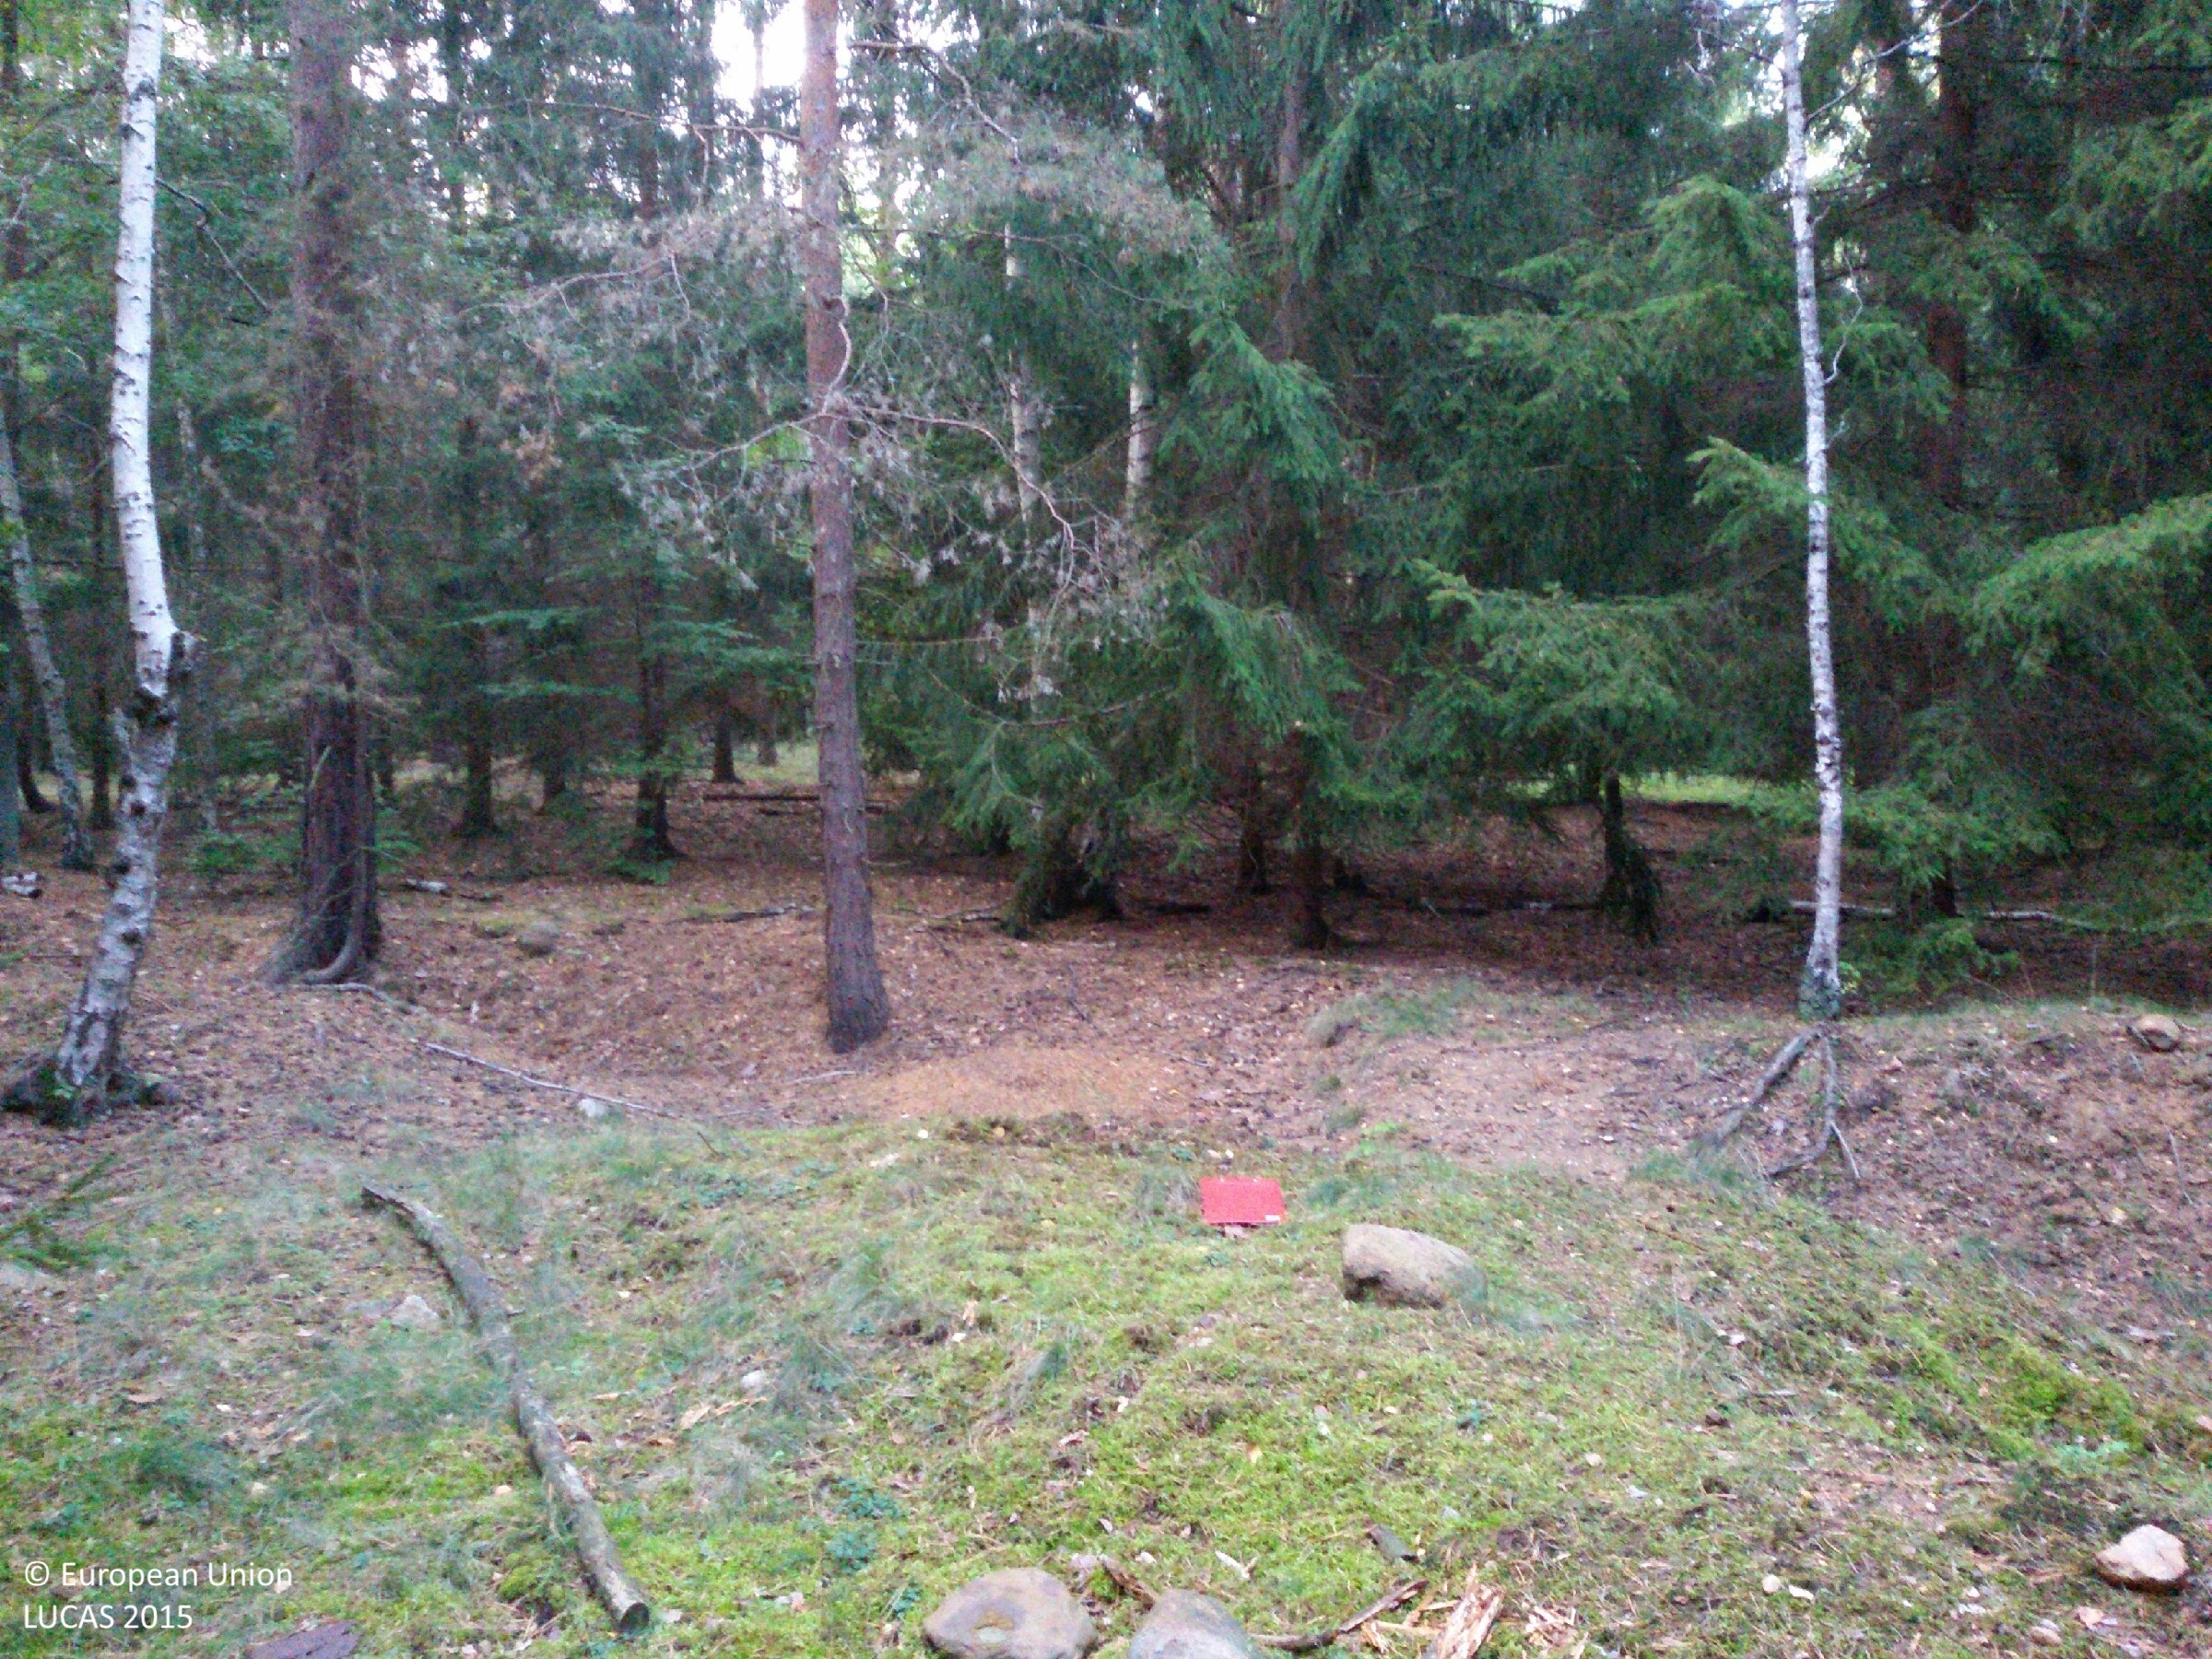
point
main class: Woodland
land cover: Pine dominated mixed woodland
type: hemiboreal forest and nemoral coniferous forest and mixed broadleaved-coniferous forest
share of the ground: > 75 %
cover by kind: coniferous forest trees 55 %, broadleaved forest trees 25 %, shrubs 10 %, herbaceous plants 5 %, lichens and mosses 5 %
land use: Forestry
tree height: > 5 m
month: September
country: PL
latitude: 51.5634
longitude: 14.7194
